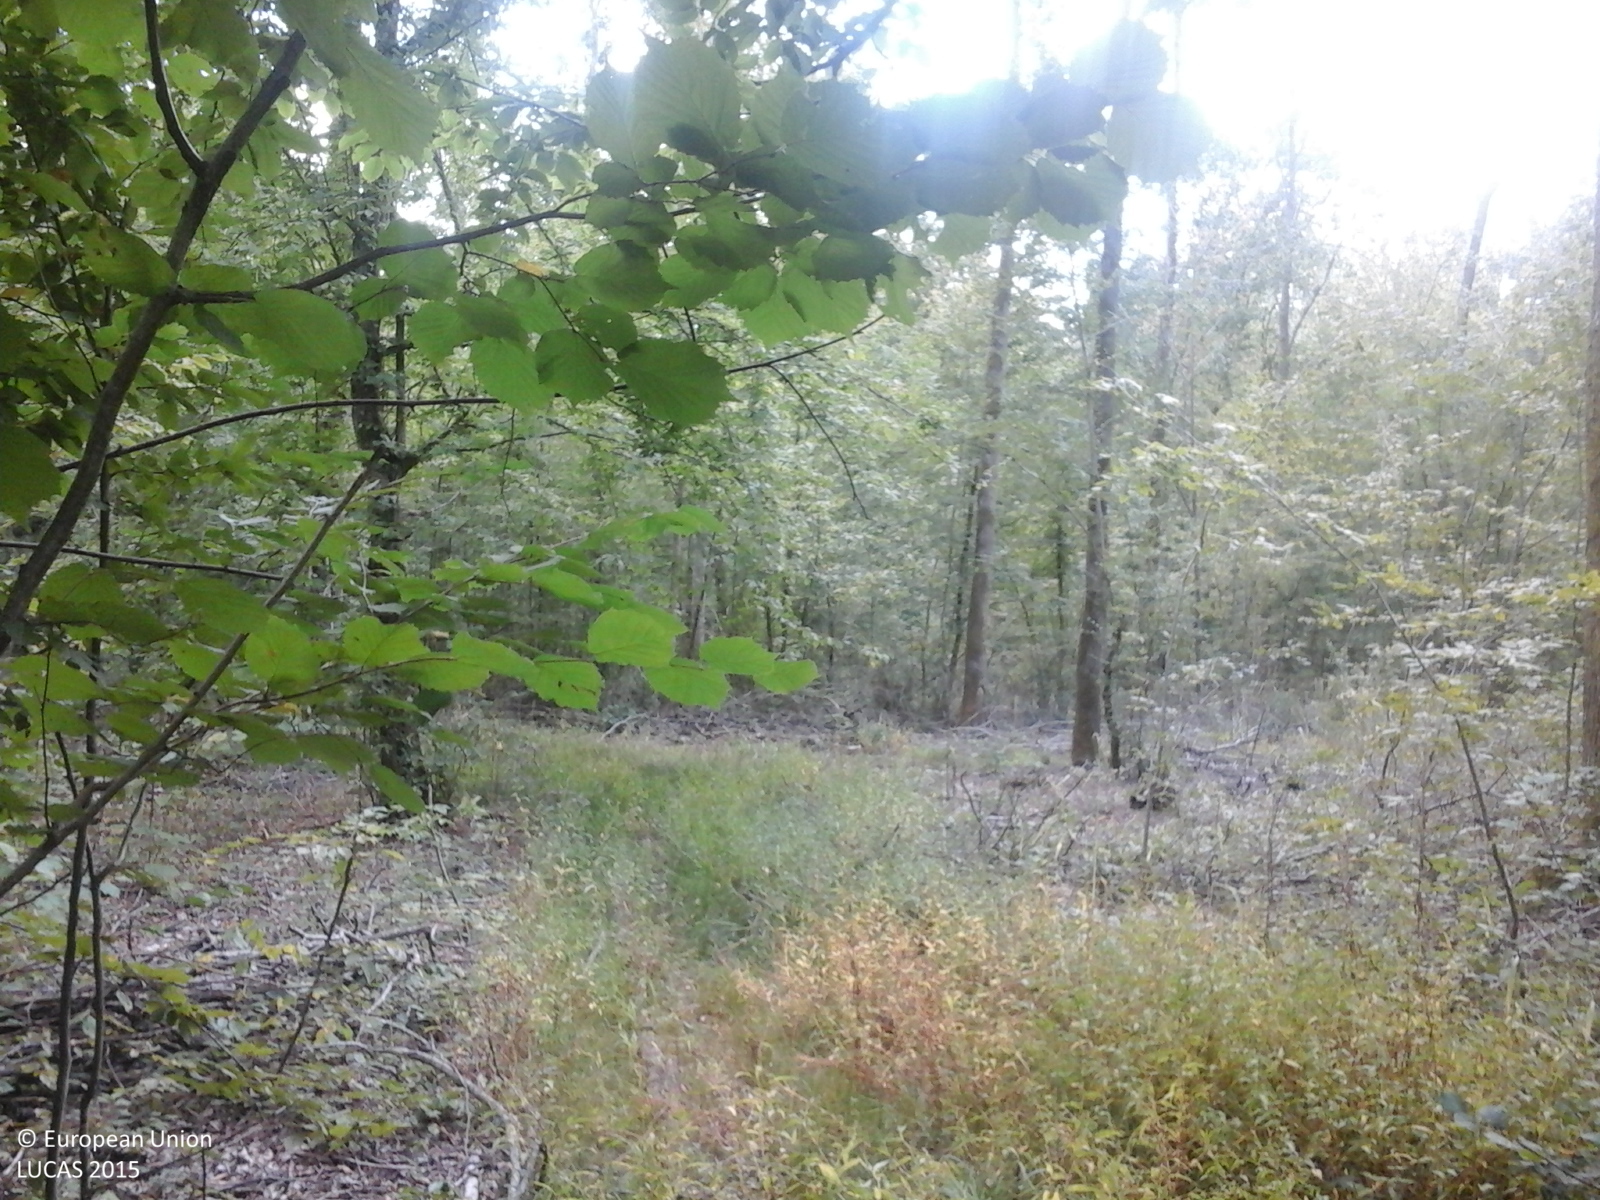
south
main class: Woodland
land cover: Broadleaved woodland
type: beech forest
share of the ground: > 75 %
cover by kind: broadleaved forest trees 90 %, herbaceous plants 10 %
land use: Forestry
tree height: > 5 m
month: September
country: RO
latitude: 47.5083
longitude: 23.4160
